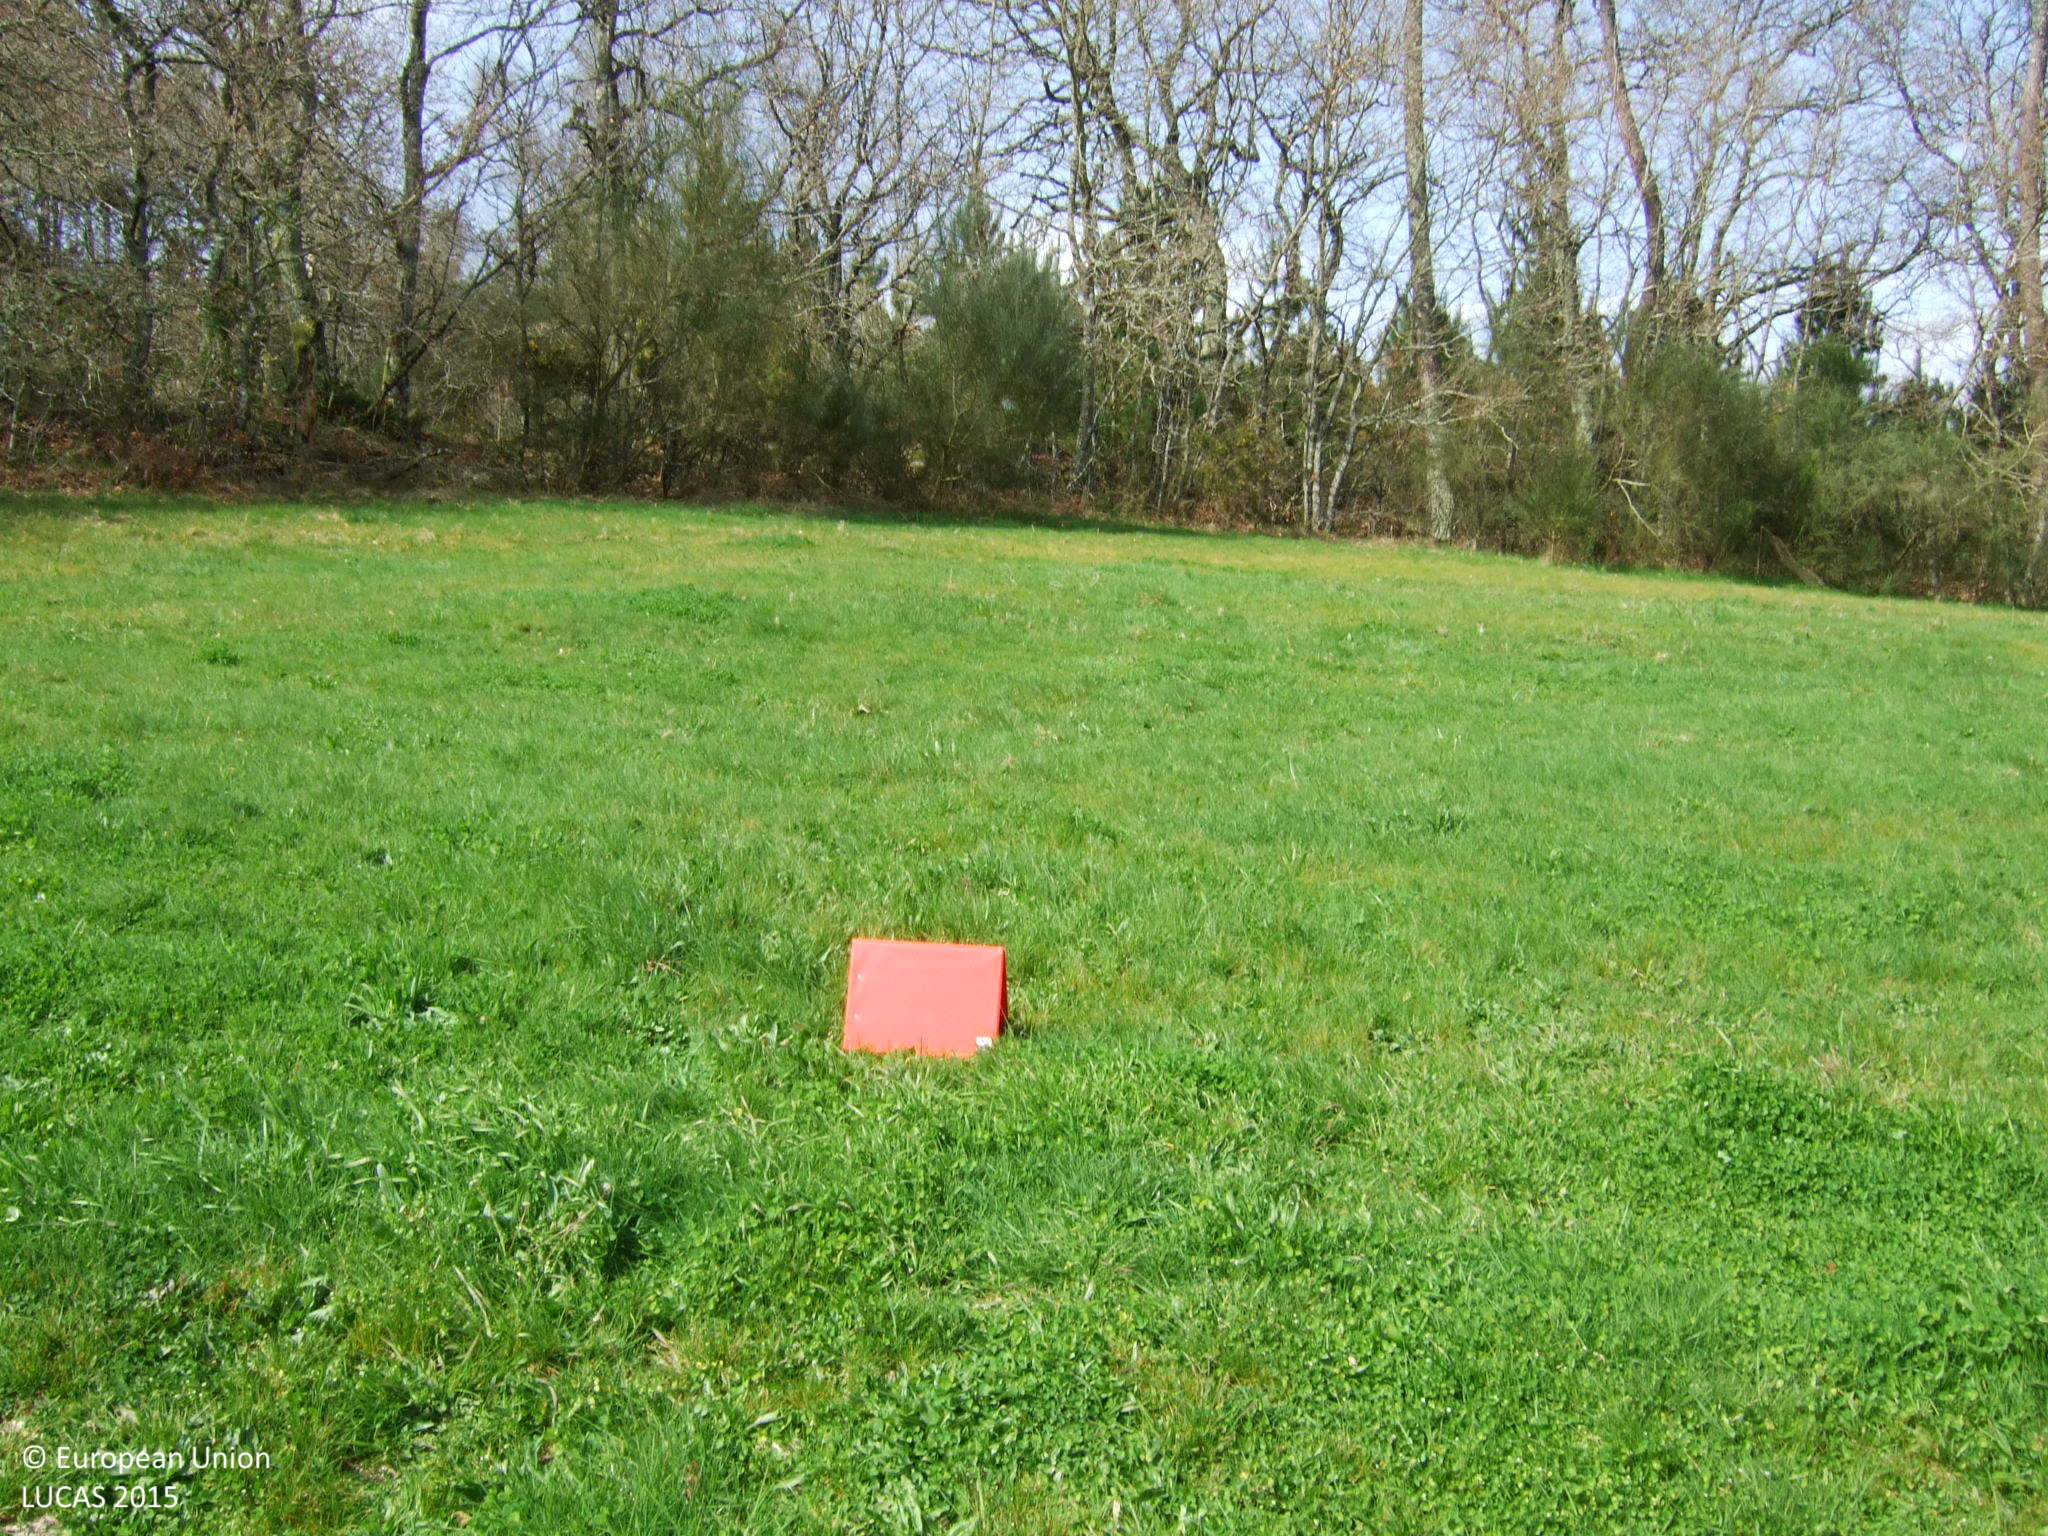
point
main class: Grassland
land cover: Grassland without tree/shrub cover
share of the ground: > 75 %
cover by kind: herbaceous plants 100 %
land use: Agriculture (excluding fallow land and kitchen gardens)
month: March
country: ES
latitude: 42.8931
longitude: -7.8776
